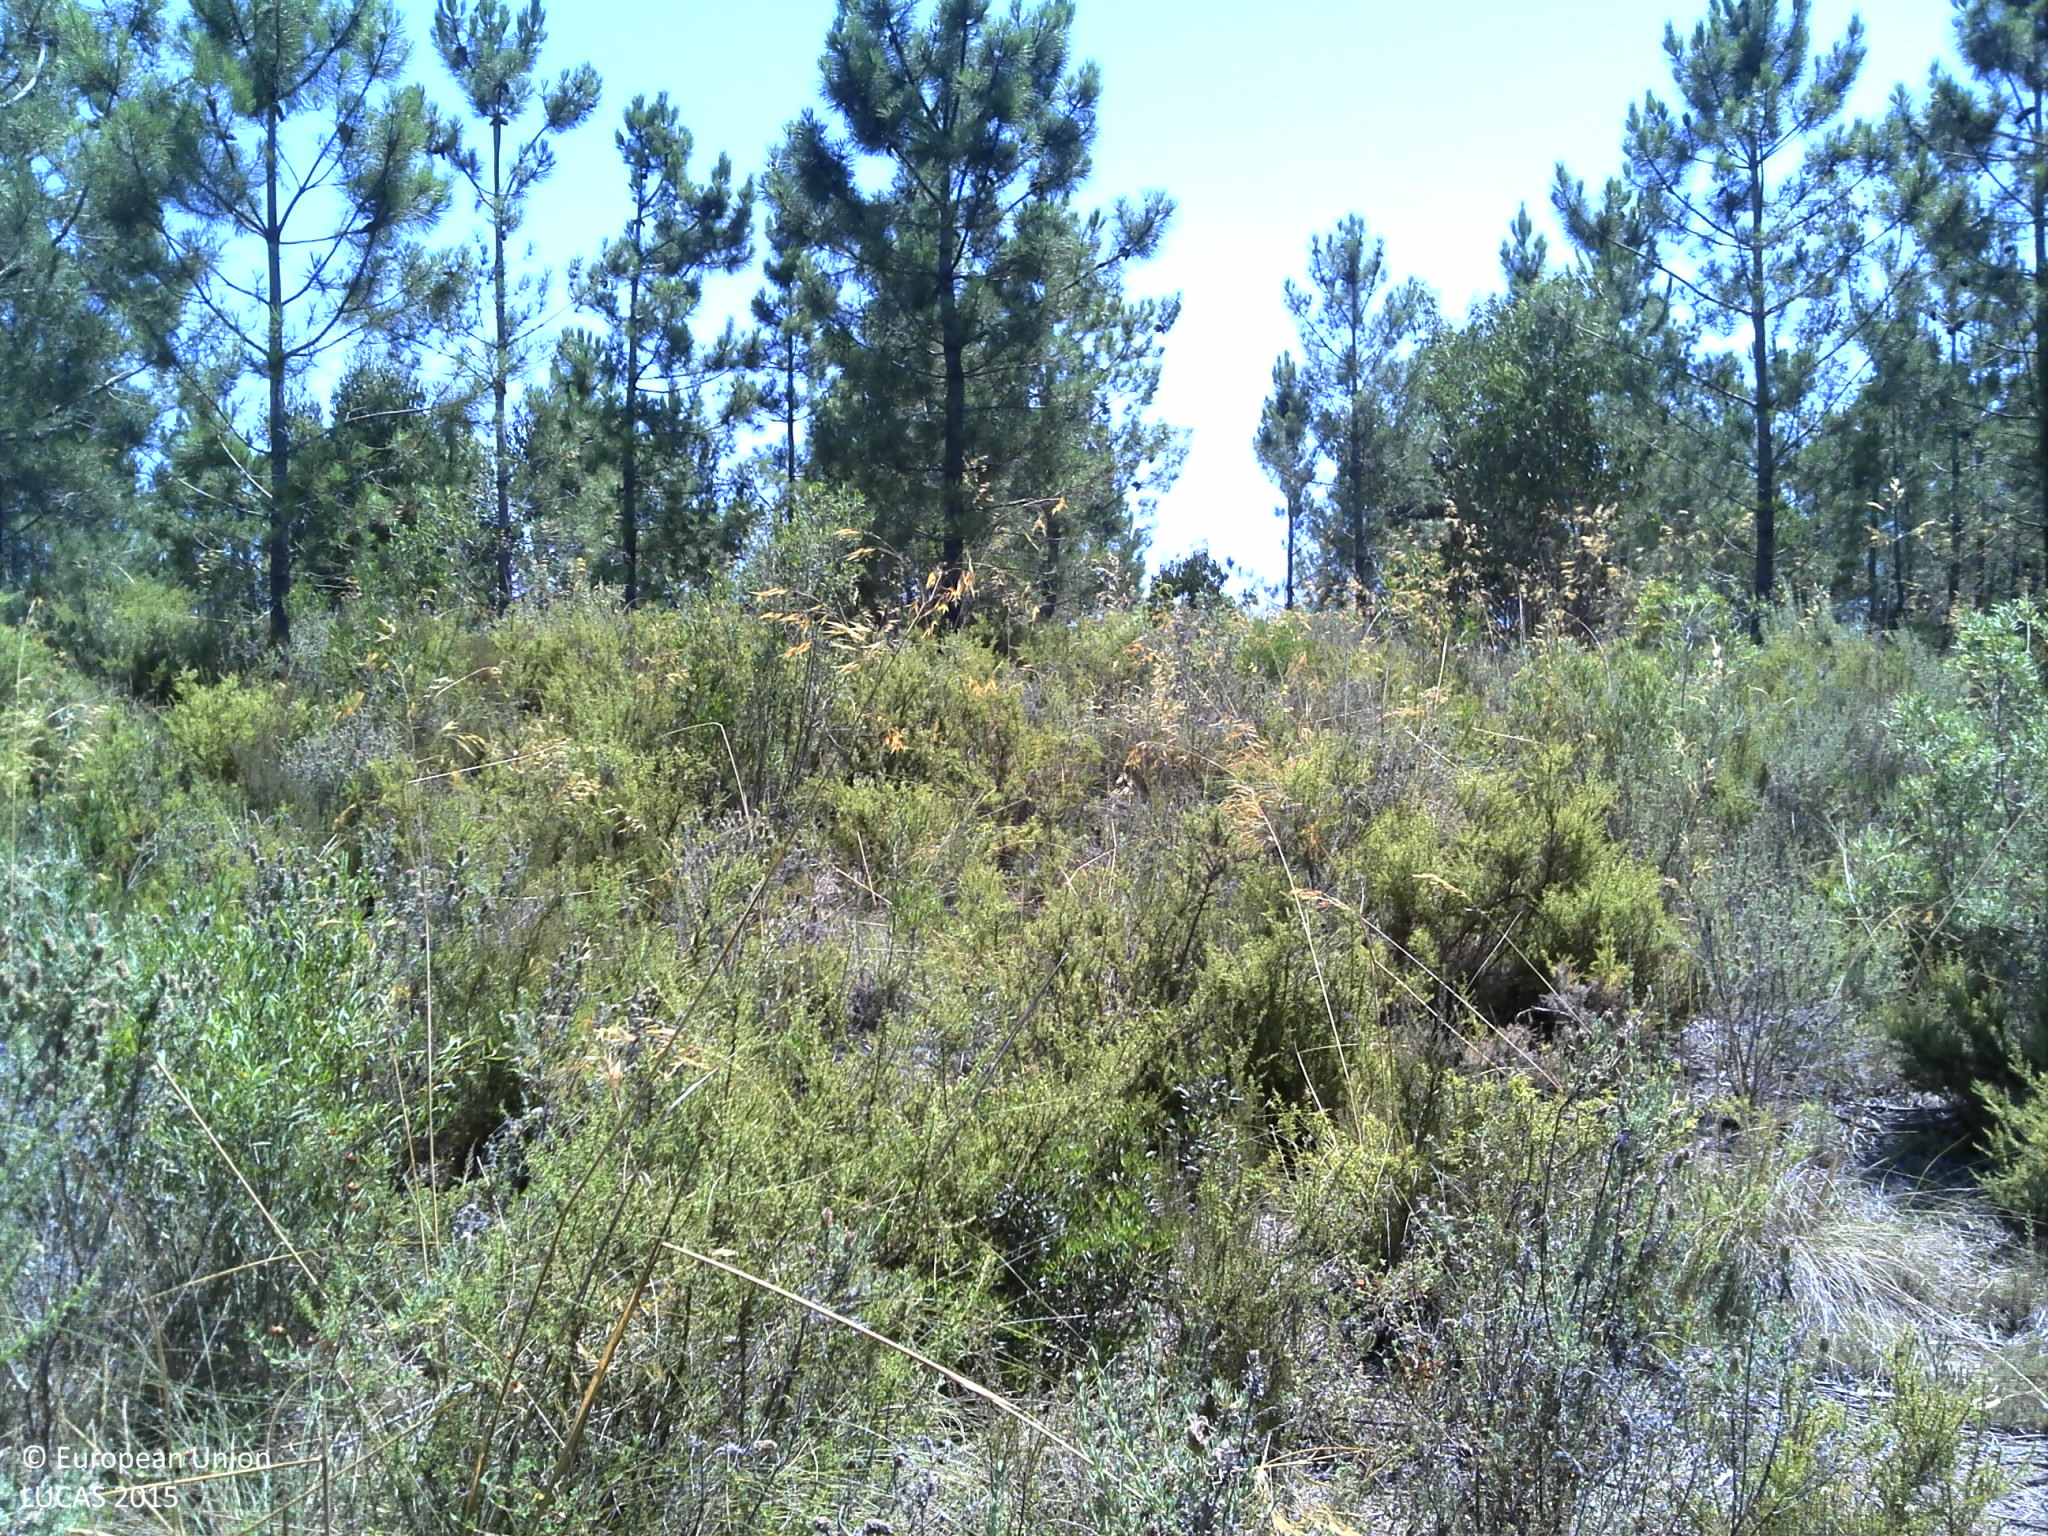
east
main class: Woodland
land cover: Pine dominated coniferous woodland
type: coniferous forest of the mediterranean region
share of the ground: 25 - 50 %
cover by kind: coniferous forest trees 40 %, shrubs 30 %, unconsolidated bare surface 25 %, herbaceous plants 5 %
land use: Forestry
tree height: > 5 m
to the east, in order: Pine dominated coniferous woodland; Broadleaved woodland; Shrubland with sparse tree cover; Tracks; Other structural elements; Pine dominated coniferous woodland; Shrubland with sparse tree cover; Other structural elements; Grassland with sparse tree/shrub cover; Electric lines; Paved roads, cycling and walking lanes; Electric lines; Fences; Grassland without tree/shrub cover; Fences; Electric lines; Paved roads, cycling and walking lanes; Grassland without tree/shrub cover
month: June
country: PT
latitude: 38.6027
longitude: -9.1457
